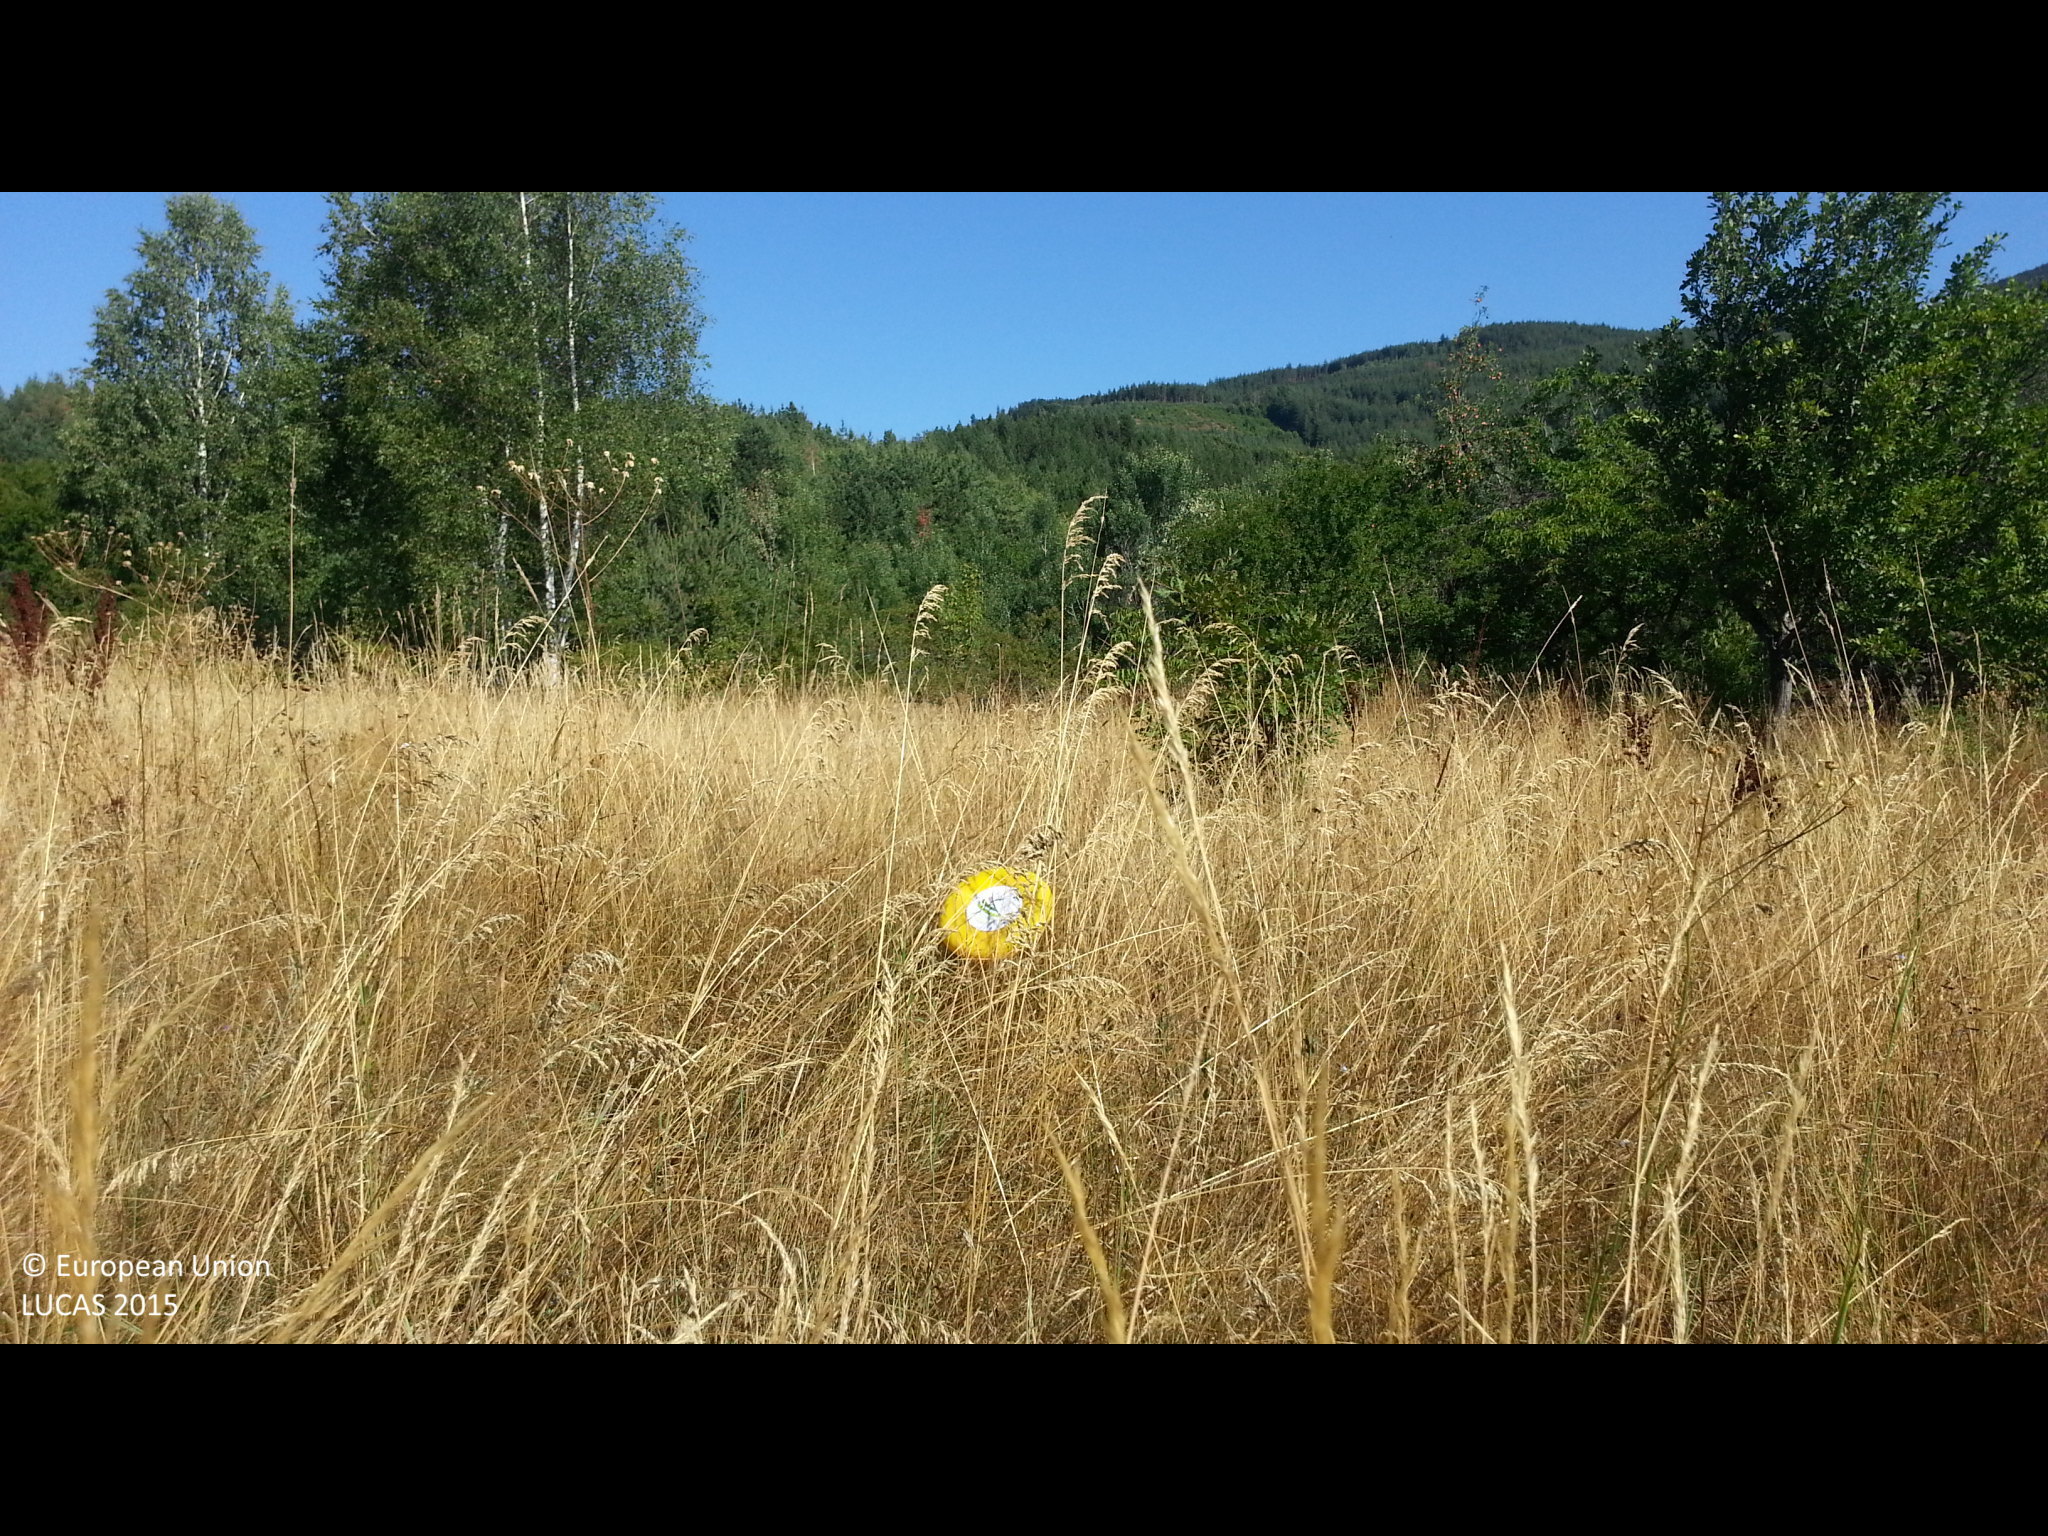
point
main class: Grassland
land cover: Grassland with sparse tree/shrub cover
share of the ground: > 75 %
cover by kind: herbaceous plants 90 %, broadleaved forest trees 5 %, shrubs 5 %
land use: Agriculture (excluding fallow land and kitchen gardens)
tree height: > 5 m
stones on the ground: < 10 %
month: August
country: BG
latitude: 42.2694
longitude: 22.5685
